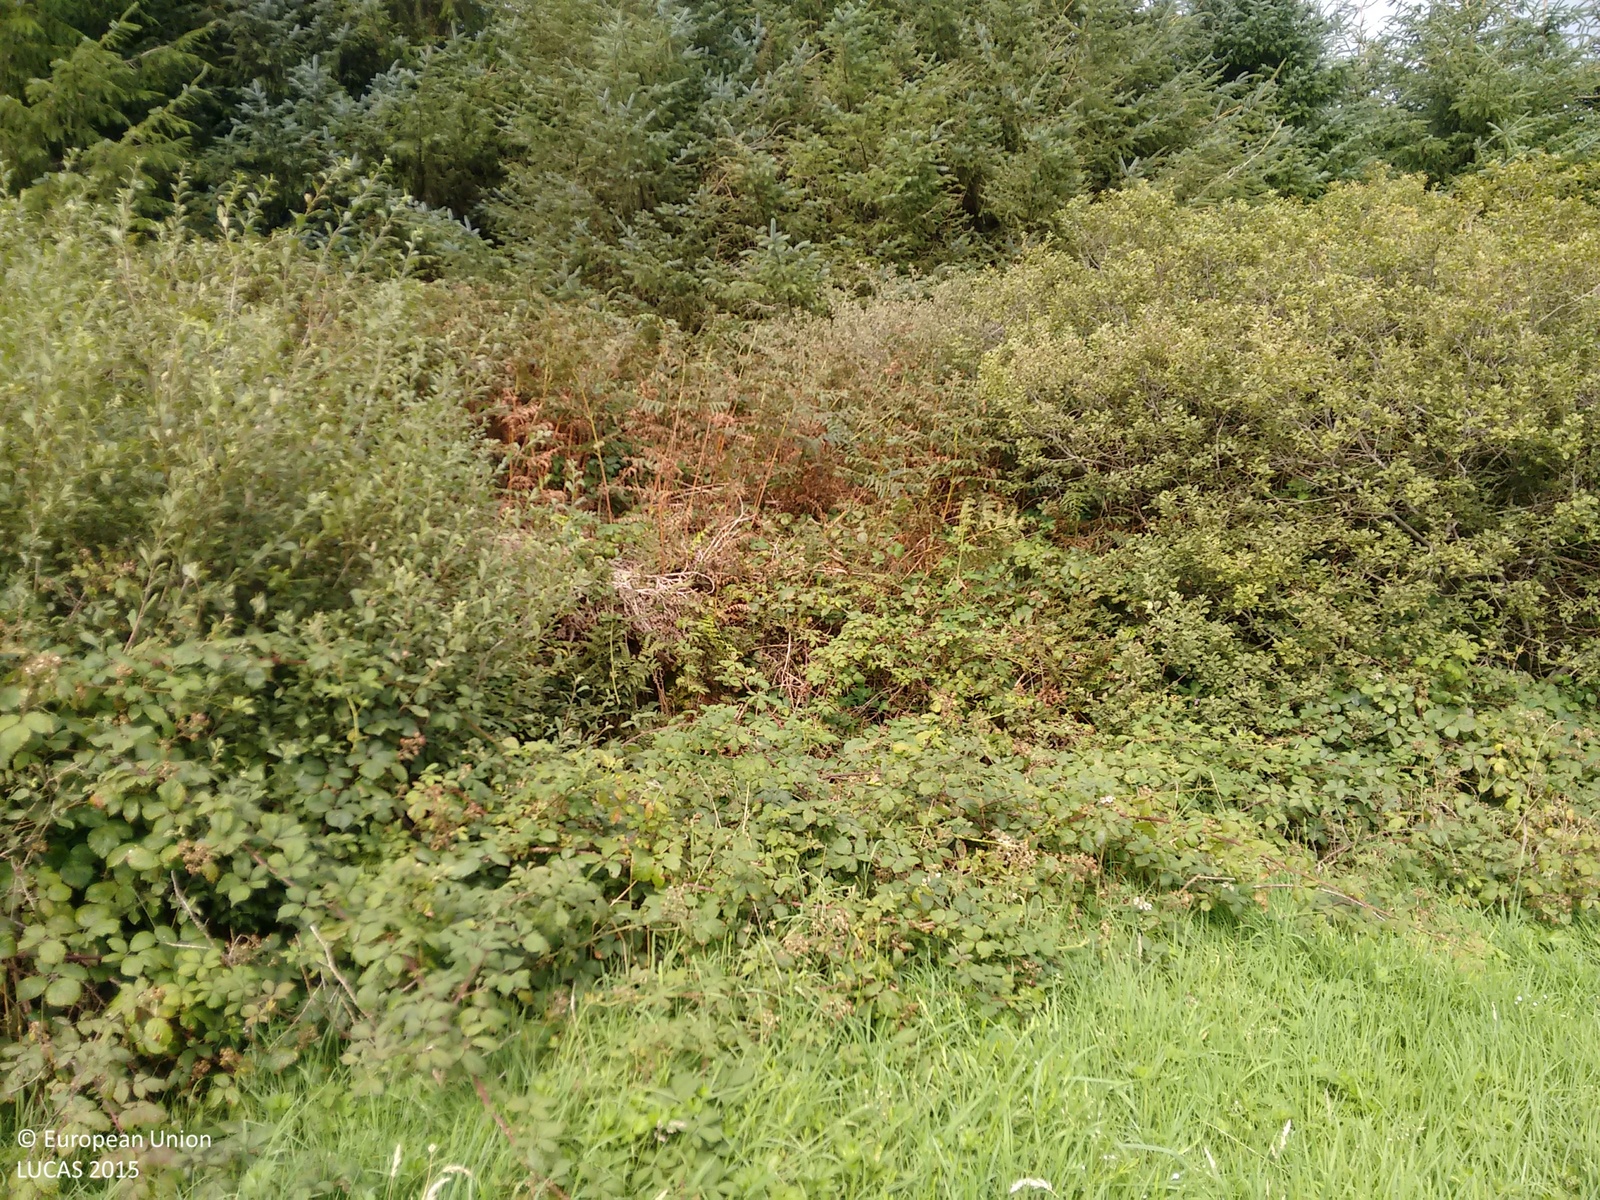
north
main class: Grassland
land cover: Grassland without tree/shrub cover
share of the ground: > 75 %
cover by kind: herbaceous plants 95 %
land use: Agriculture (excluding fallow land and kitchen gardens)
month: September
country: IE
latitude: 52.9201
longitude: -9.1834
